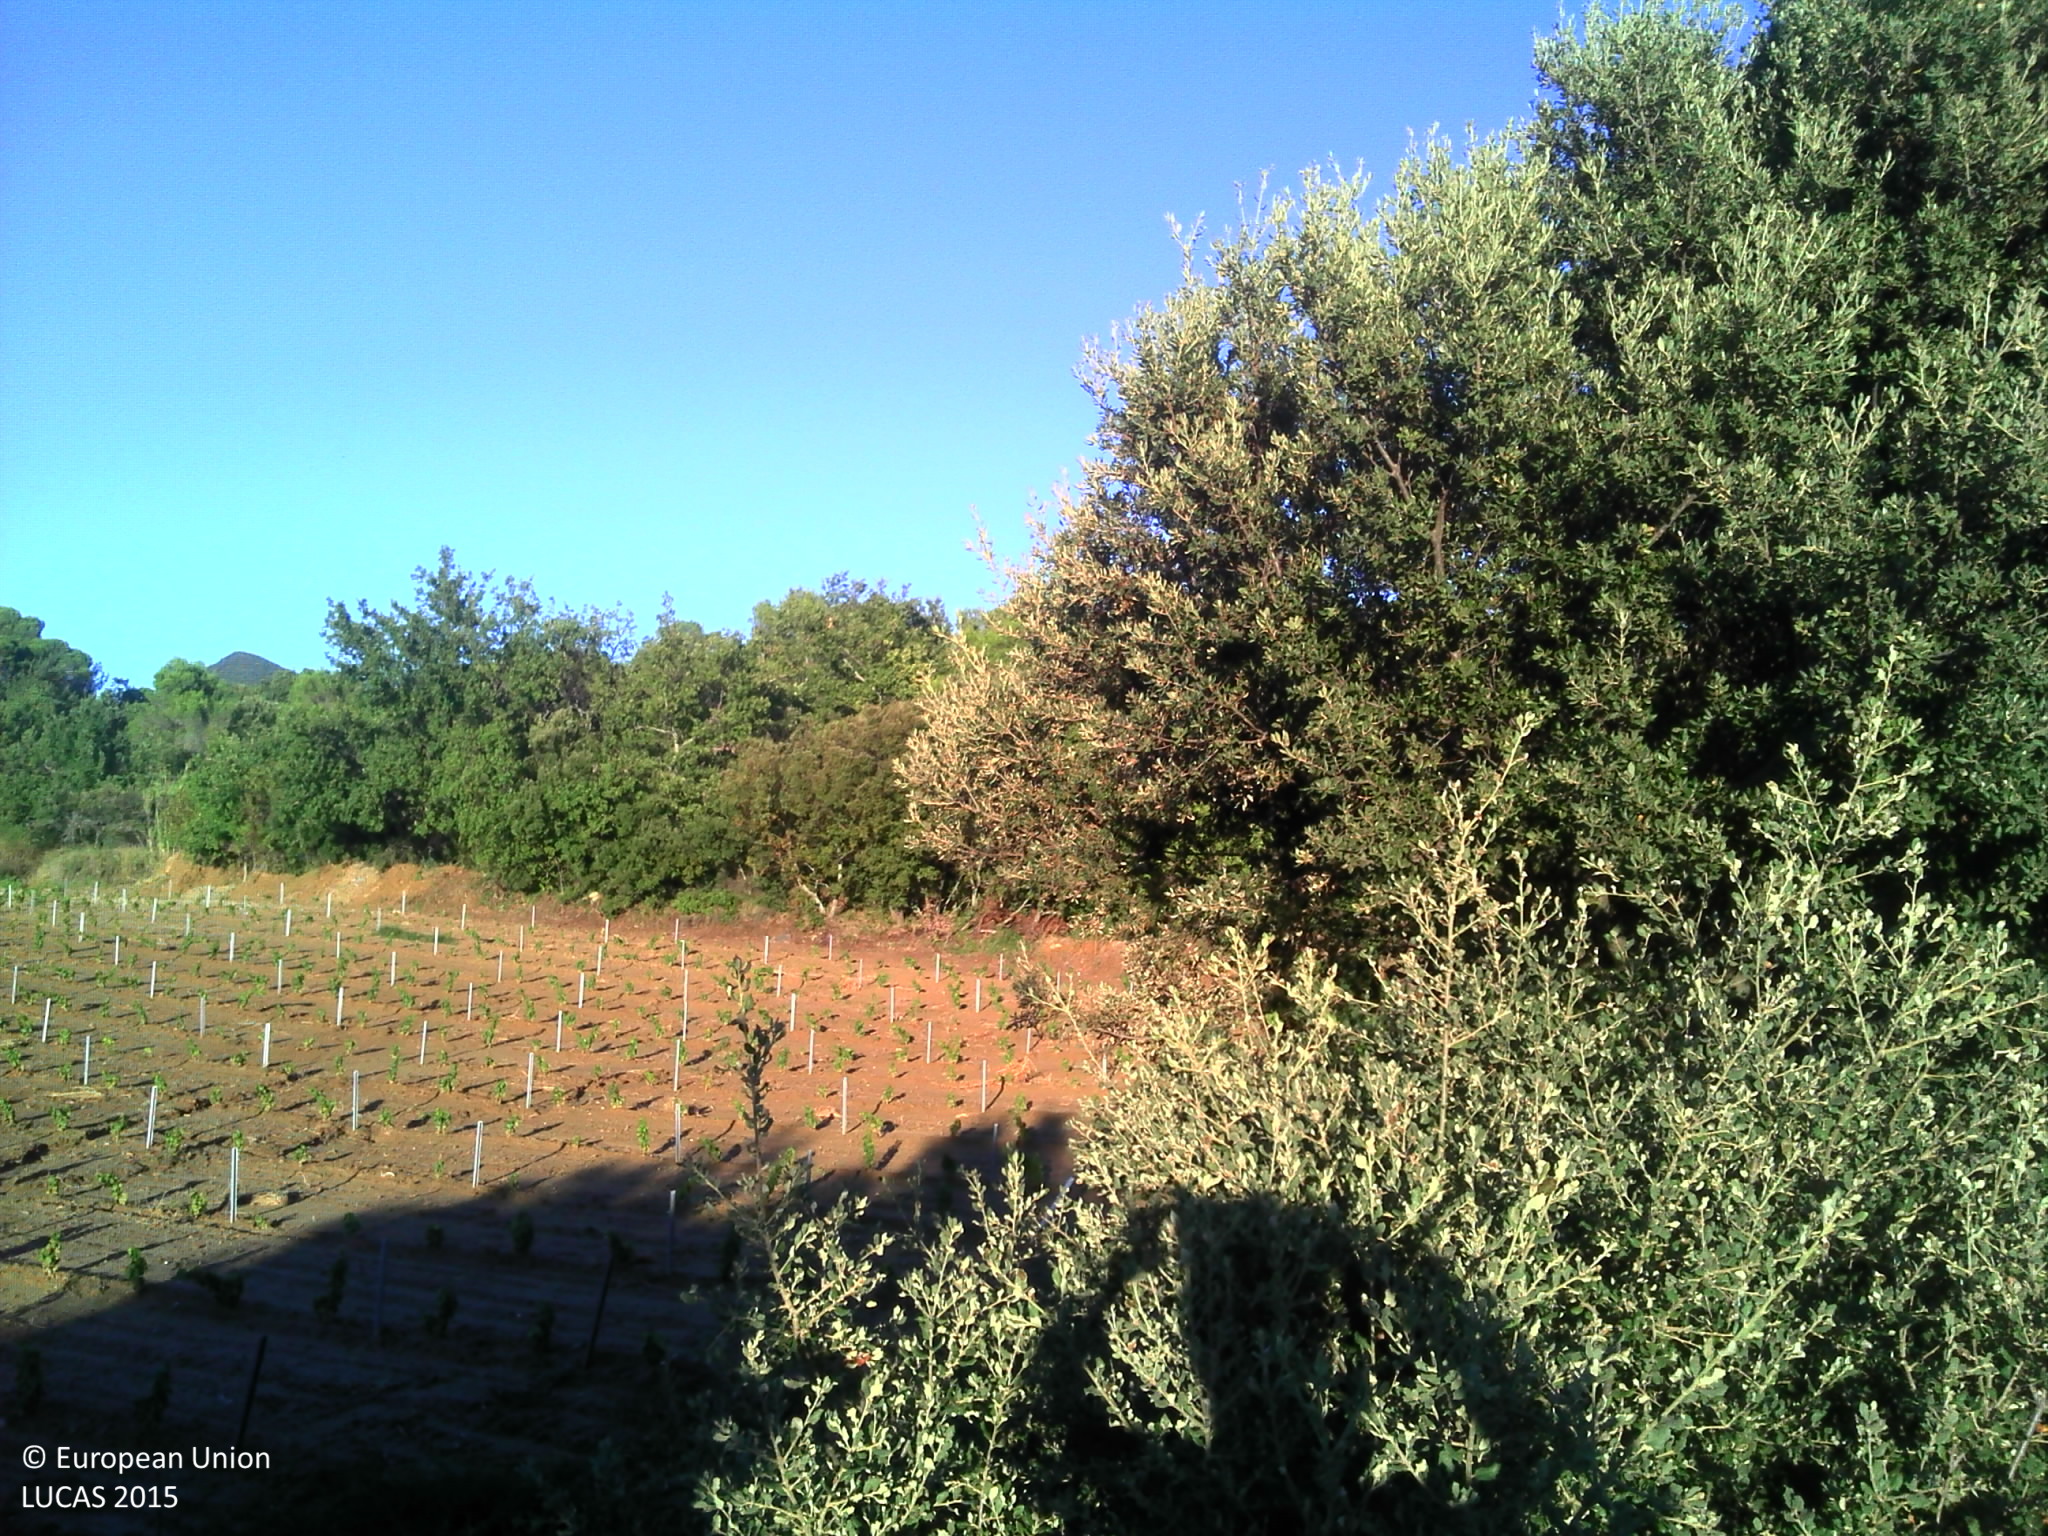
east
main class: Cropland
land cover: Vineyards
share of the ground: 10 - 25 %
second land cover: Other bare soil
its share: > 75 %
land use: Agriculture (excluding fallow land and kitchen gardens)
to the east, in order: Vineyards; Other bare soil; Pine dominated mixed woodland; Tracks; Pine dominated mixed woodland; Rivers and streams; Pine dominated mixed woodland; Tracks; Vineyards; Electric lines; Vineyards
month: September
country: FR
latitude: 44.2894
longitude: 5.1076
